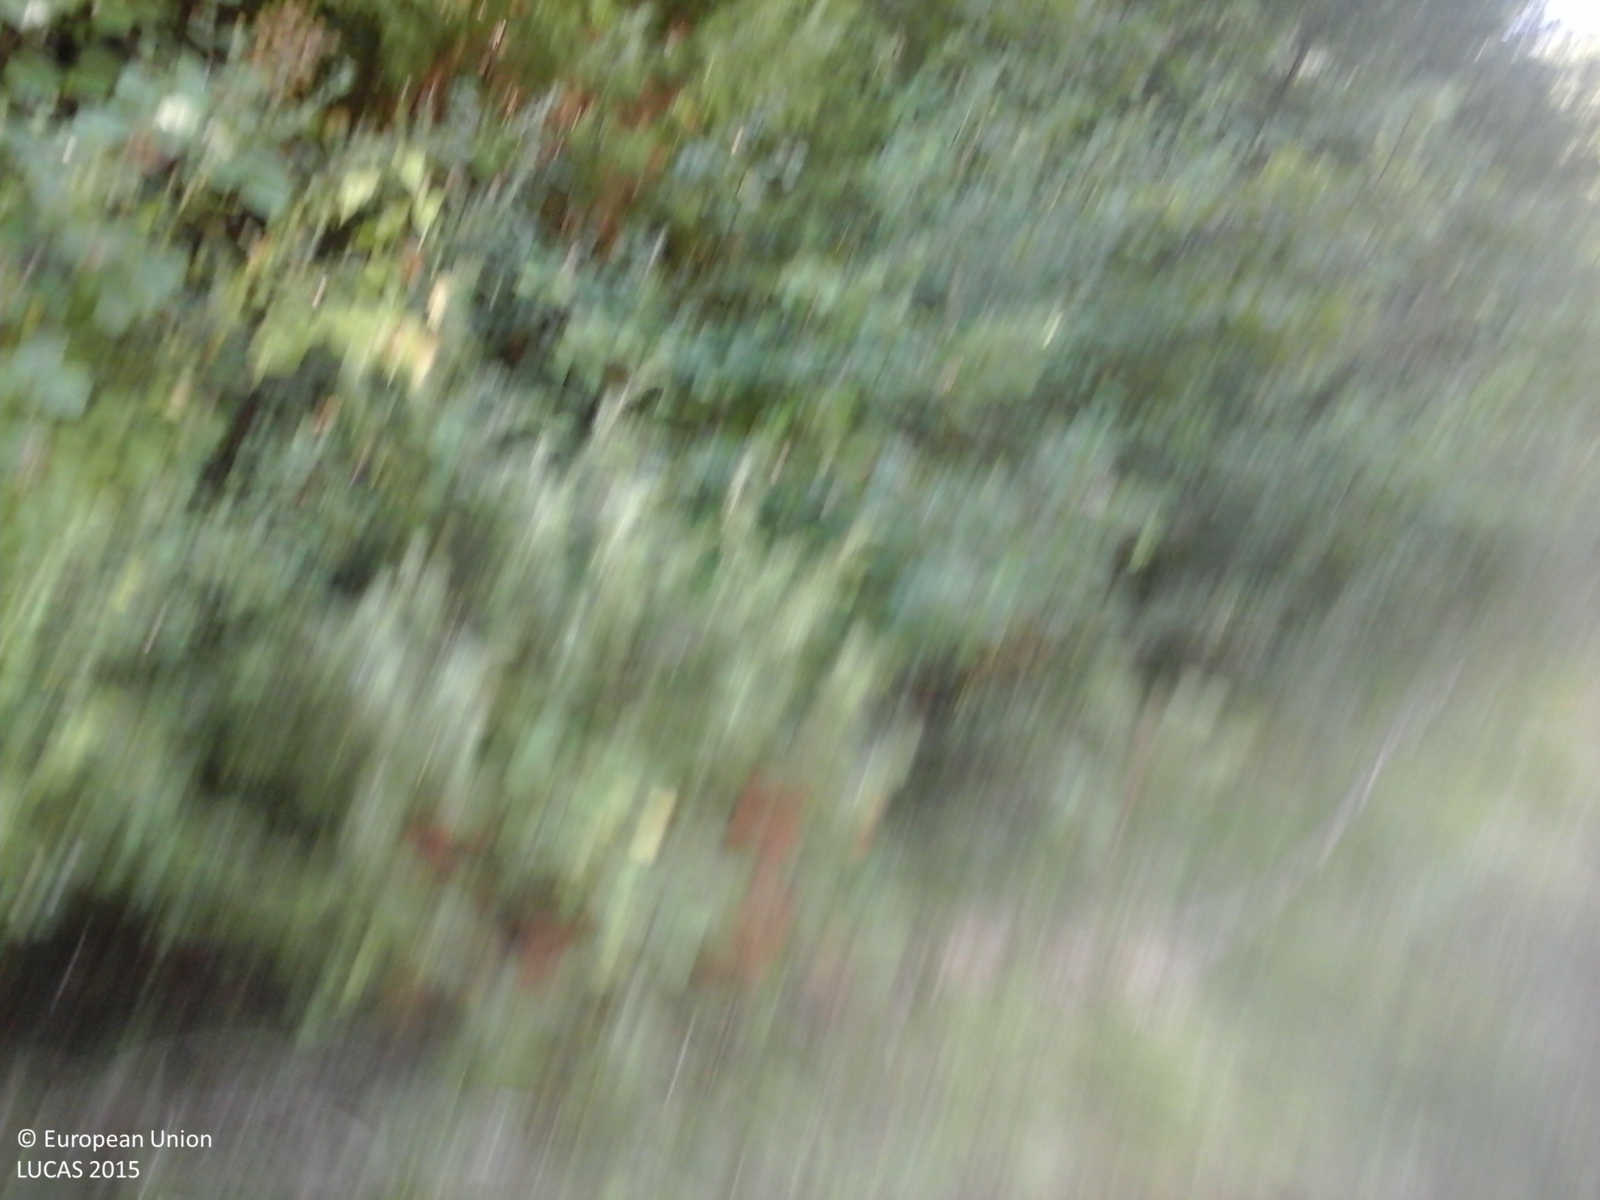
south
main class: Grassland
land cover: Grassland without tree/shrub cover
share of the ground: > 75 %
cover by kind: herbaceous plants 90 %, shrubs 5 %, unconsolidated bare surface 5 %
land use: Agriculture (excluding fallow land and kitchen gardens)
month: July
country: IT
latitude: 43.0943
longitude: 11.5066
